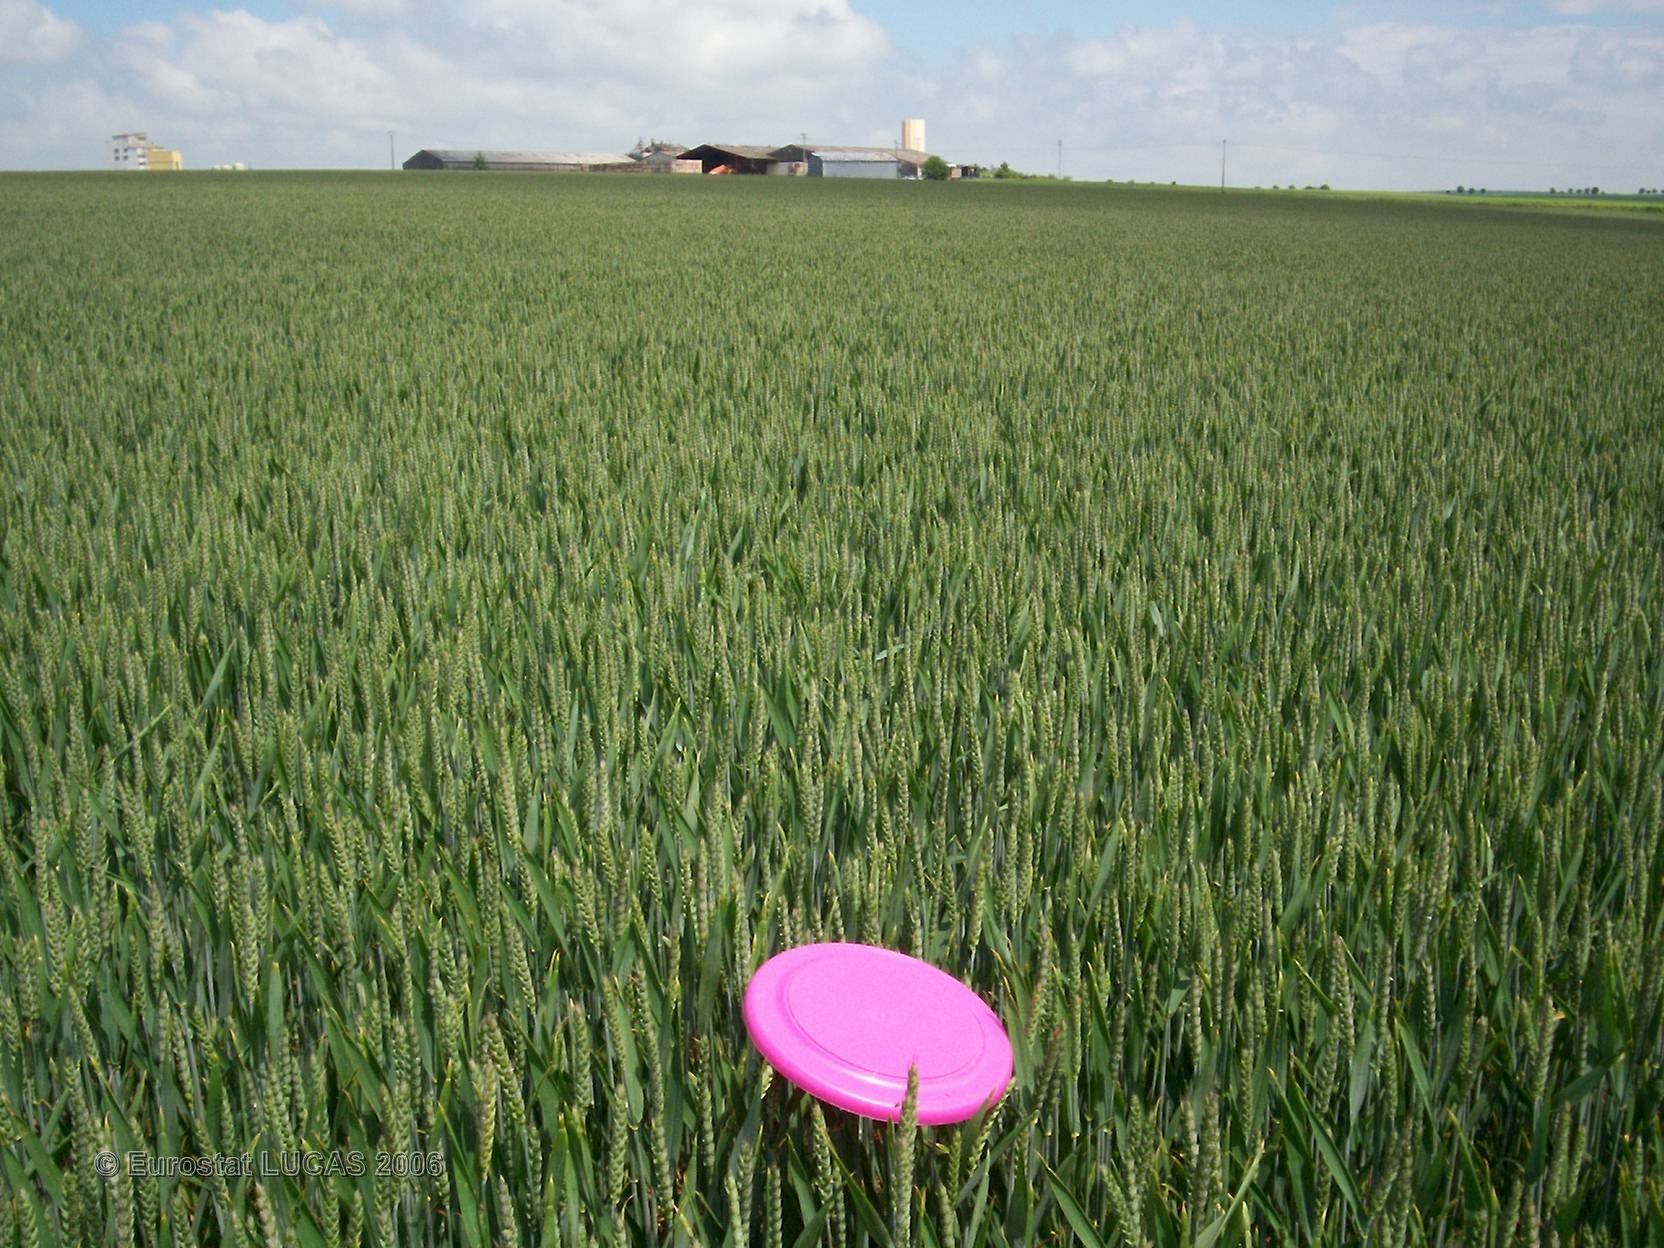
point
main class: Cropland
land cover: Common wheat
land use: Agriculture (excluding fallow land and kitchen gardens)
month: June
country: FR
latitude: 48.6054
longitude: 4.4230
